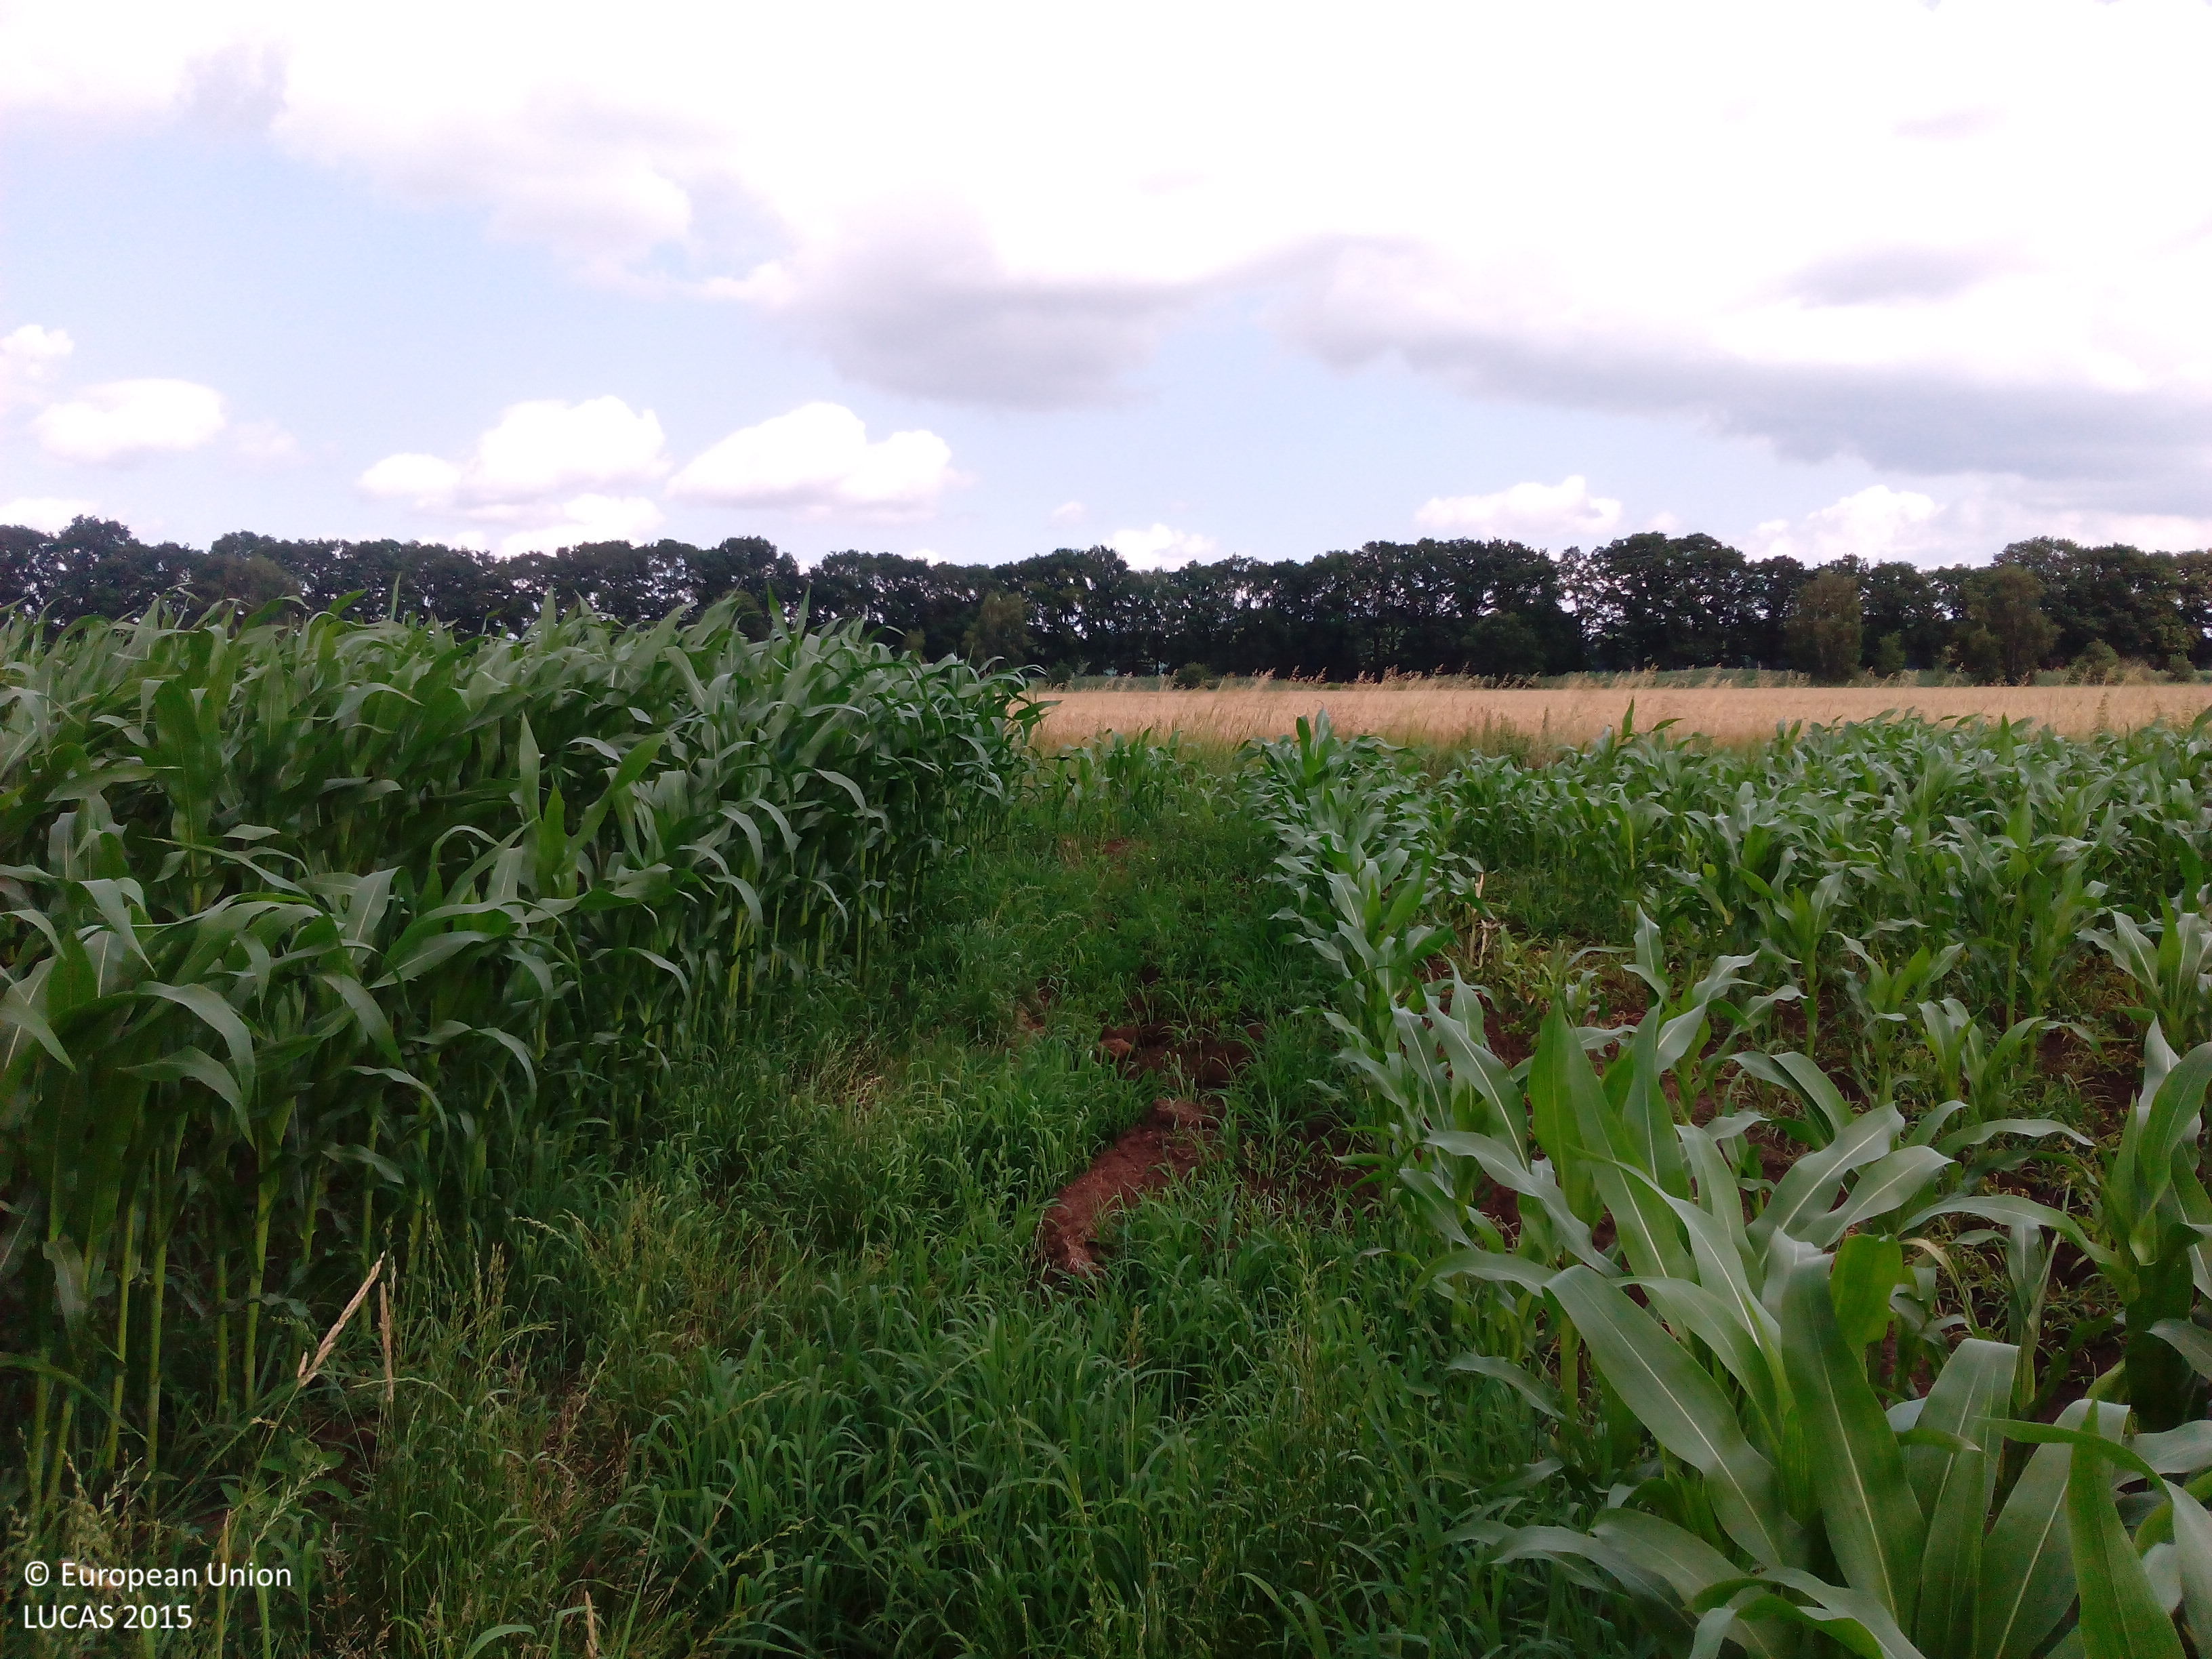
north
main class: Cropland
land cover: Maize
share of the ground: > 75 %
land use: Agriculture (excluding fallow land and kitchen gardens)
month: July
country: DE
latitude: 52.6659
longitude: 7.9748
